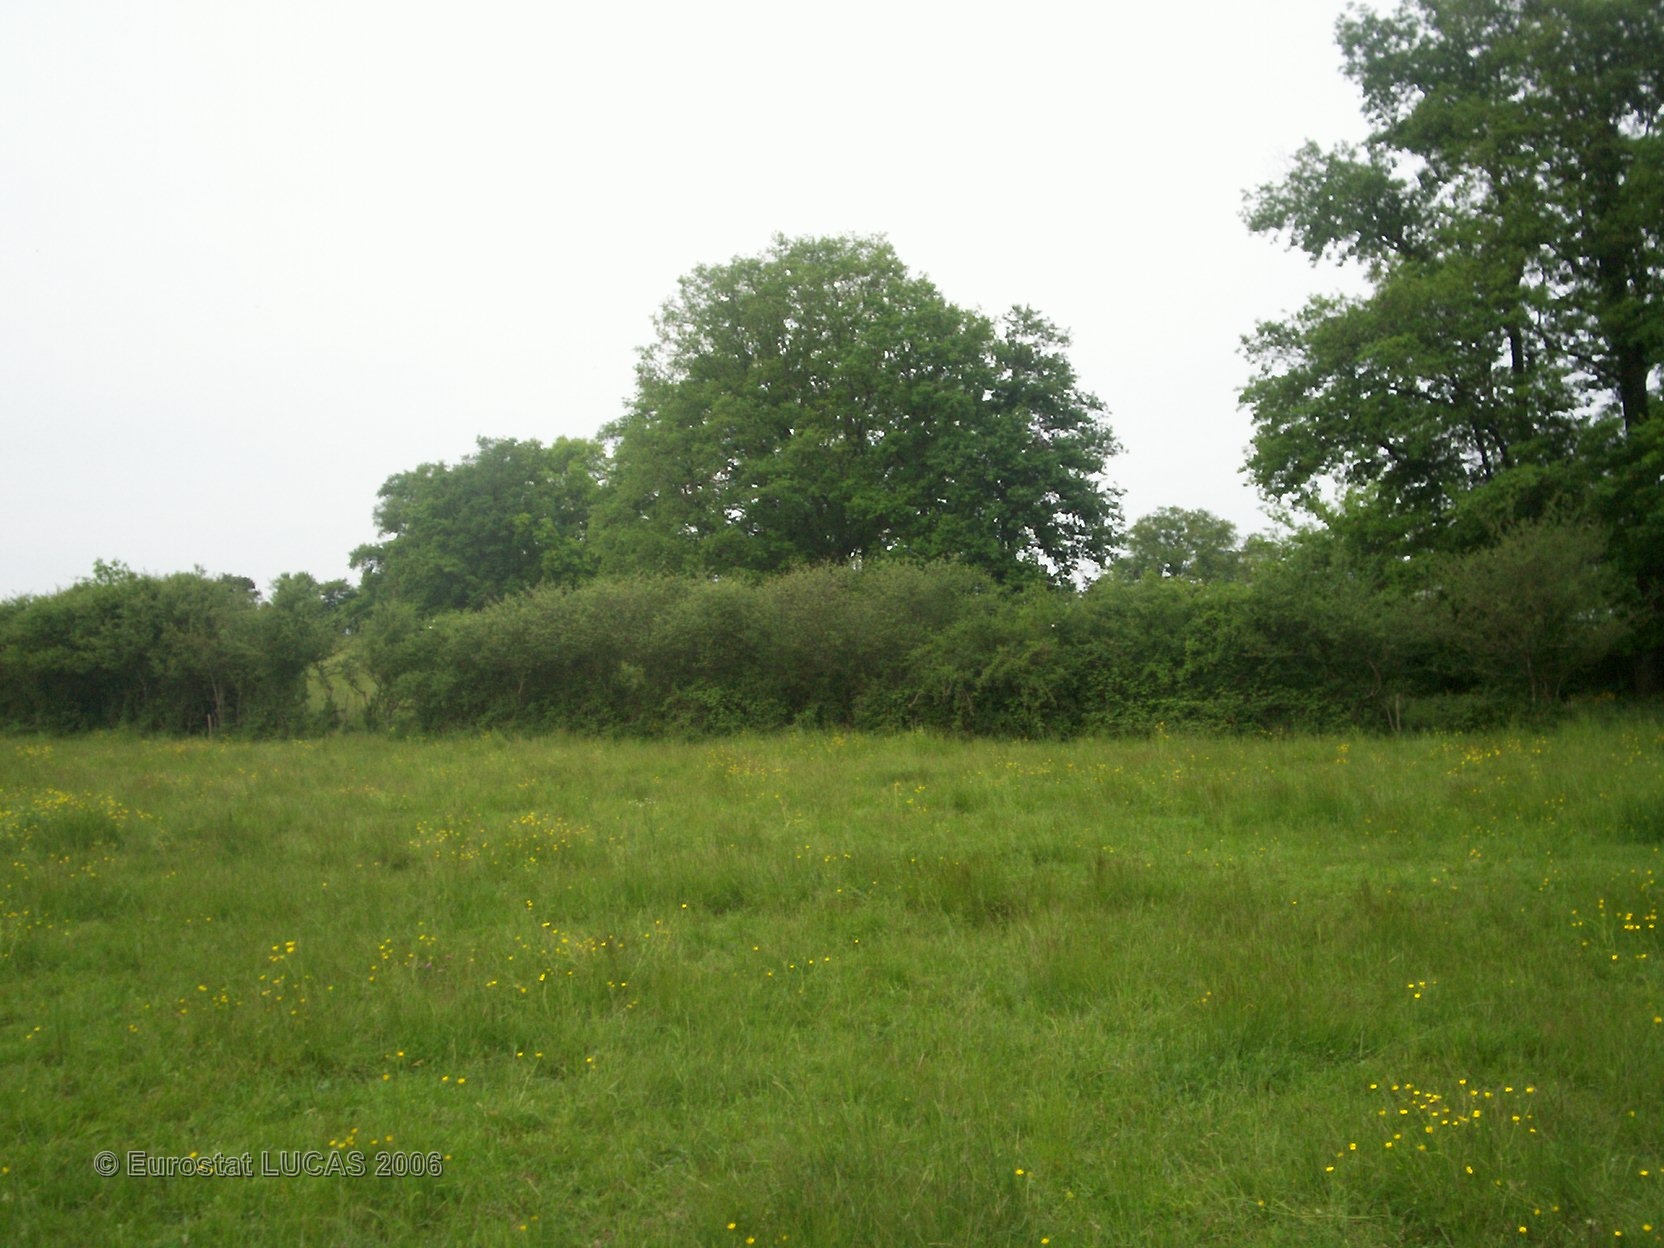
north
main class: Grassland
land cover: Grassland with sparse tree/shrub cover
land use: Agriculture (excluding fallow land and kitchen gardens)
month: May
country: FR
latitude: 46.6355
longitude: 4.7110
